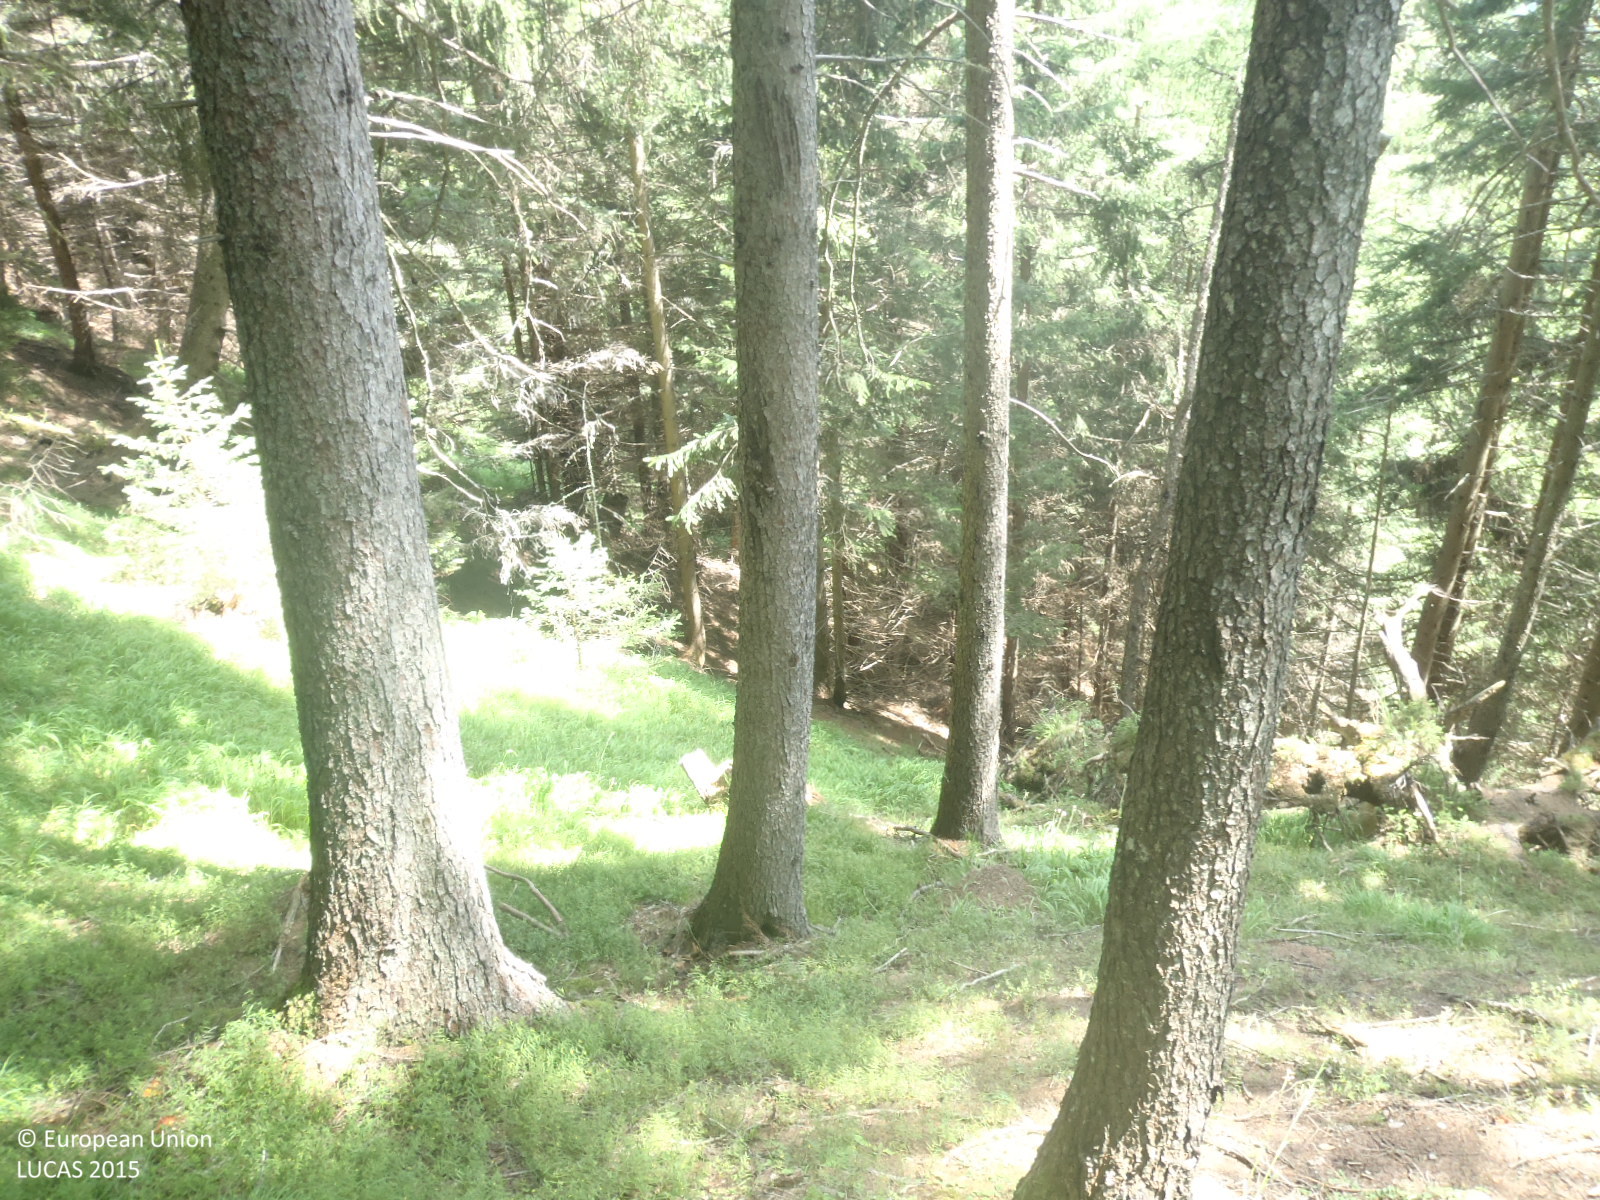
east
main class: Woodland
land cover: Spruce dominated coniferous woodland
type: alpine coniferous forest
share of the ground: > 75 %
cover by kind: coniferous forest trees 90 %, herbaceous plants 10 %
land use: Forestry
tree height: > 5 m
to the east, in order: Spruce dominated coniferous woodland; Other coniferous woodland; Tracks; Other coniferous woodland; Fences; Tracks; Grassland without tree/shrub cover; Broadleaved woodland; Dry stone walls; Fences; Broadleaved woodland
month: August
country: AT
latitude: 47.0064
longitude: 12.5100
